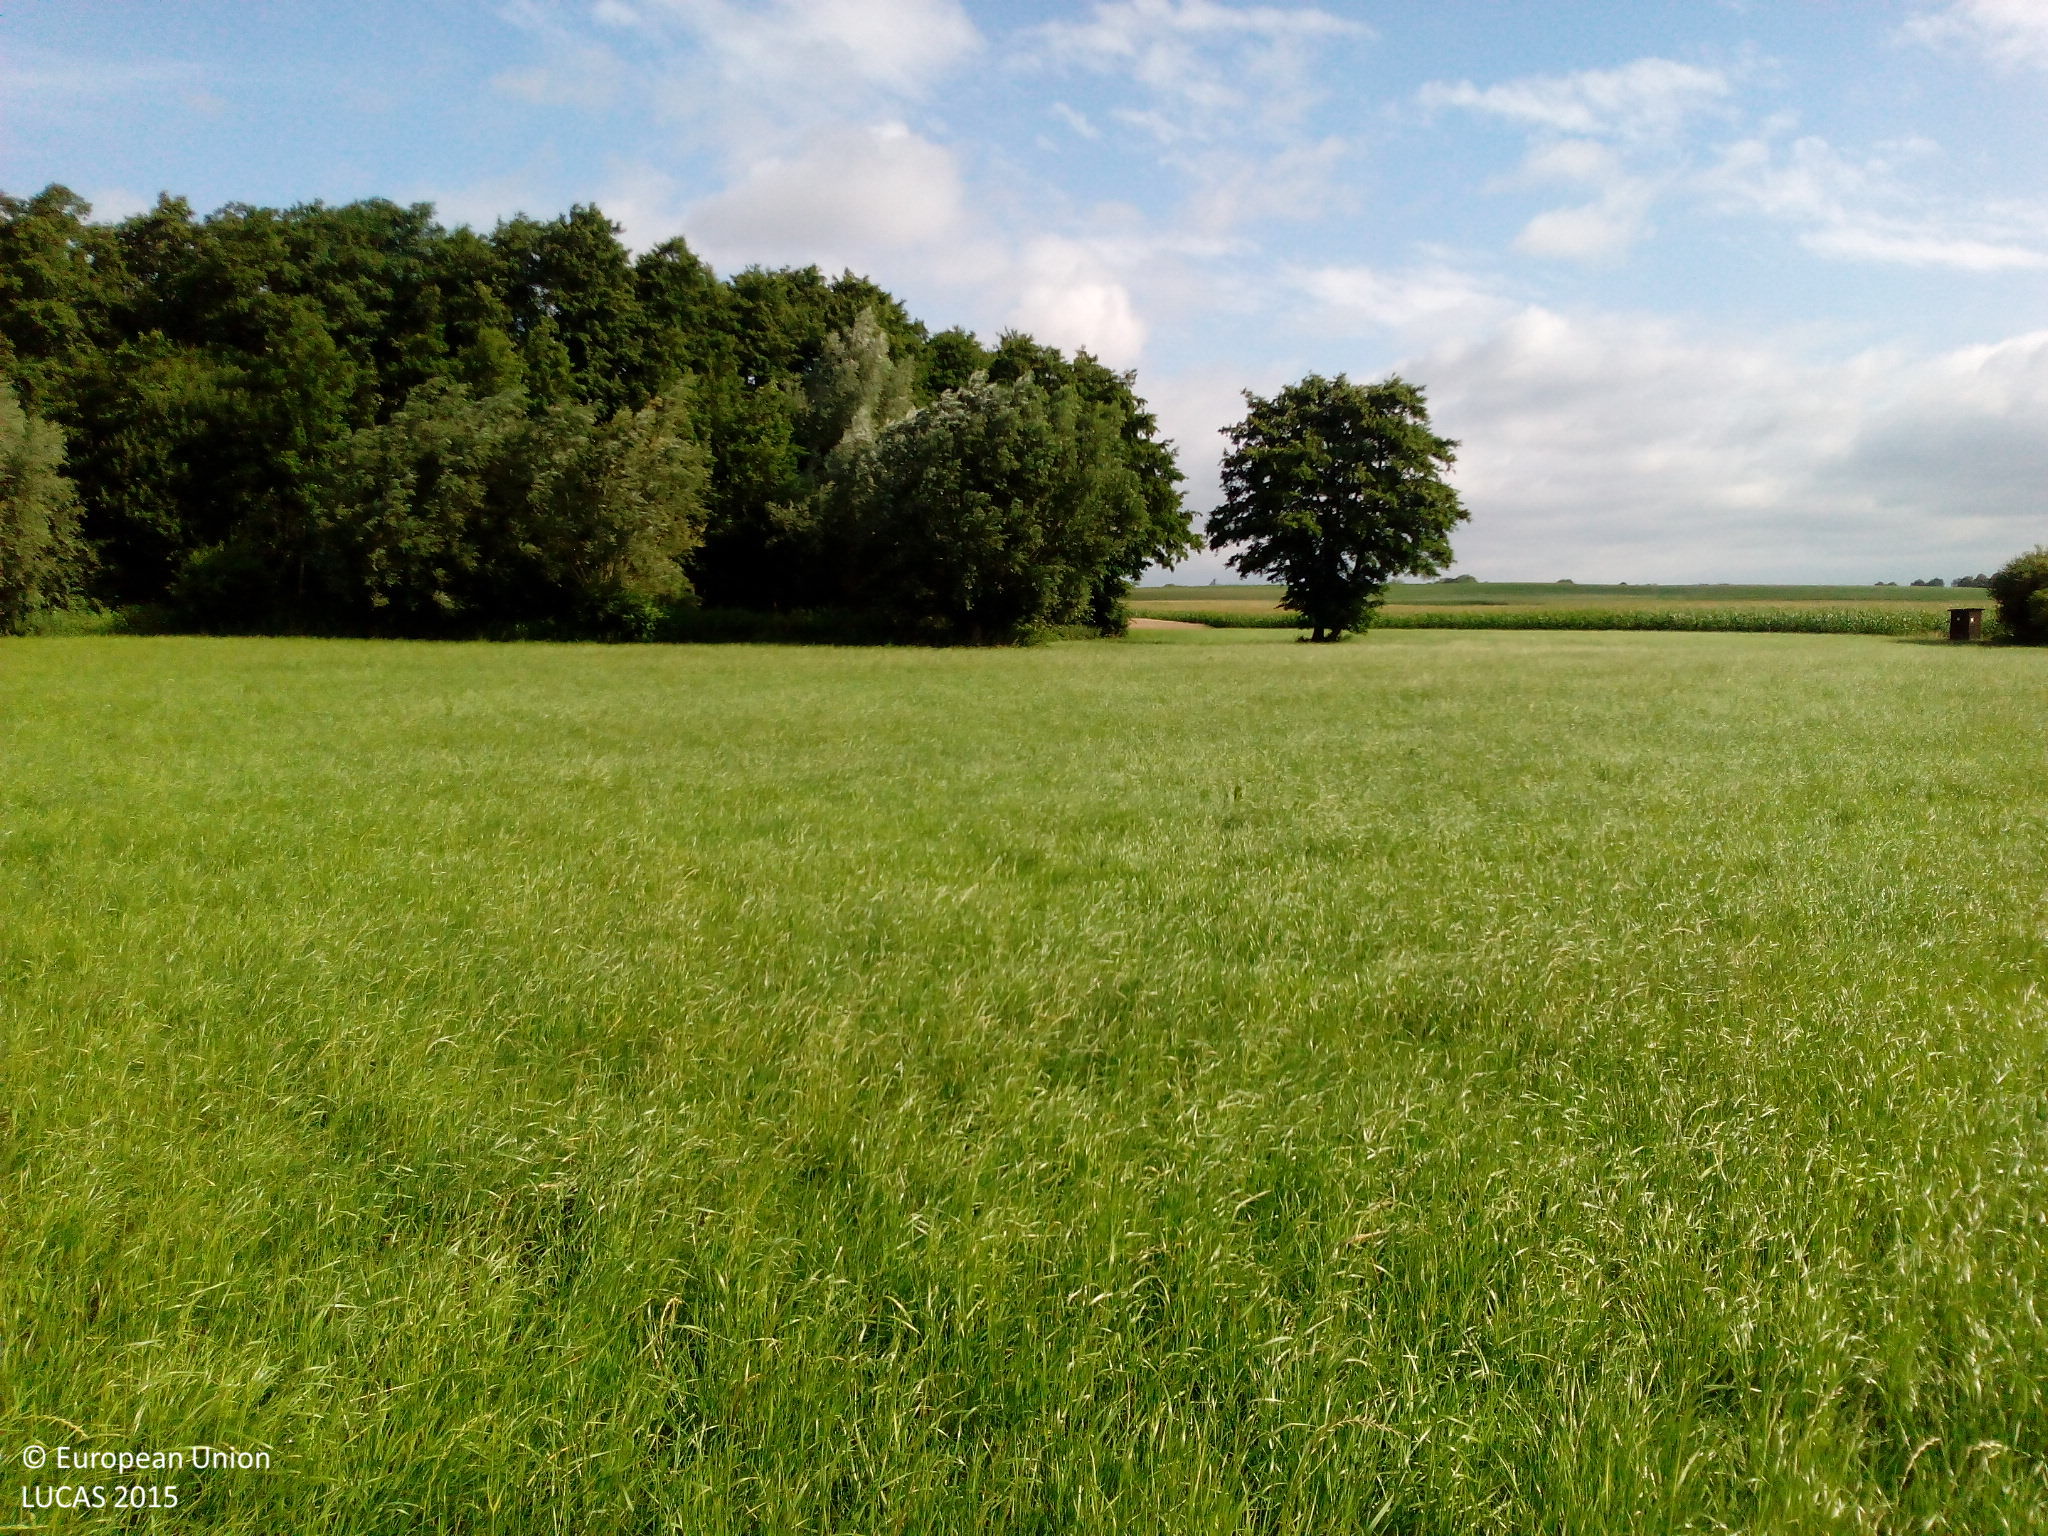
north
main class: Grassland
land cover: Grassland without tree/shrub cover
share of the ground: > 75 %
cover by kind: herbaceous plants 100 %
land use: Agriculture (excluding fallow land and kitchen gardens)
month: July
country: DE
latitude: 51.5301
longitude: 9.2362
